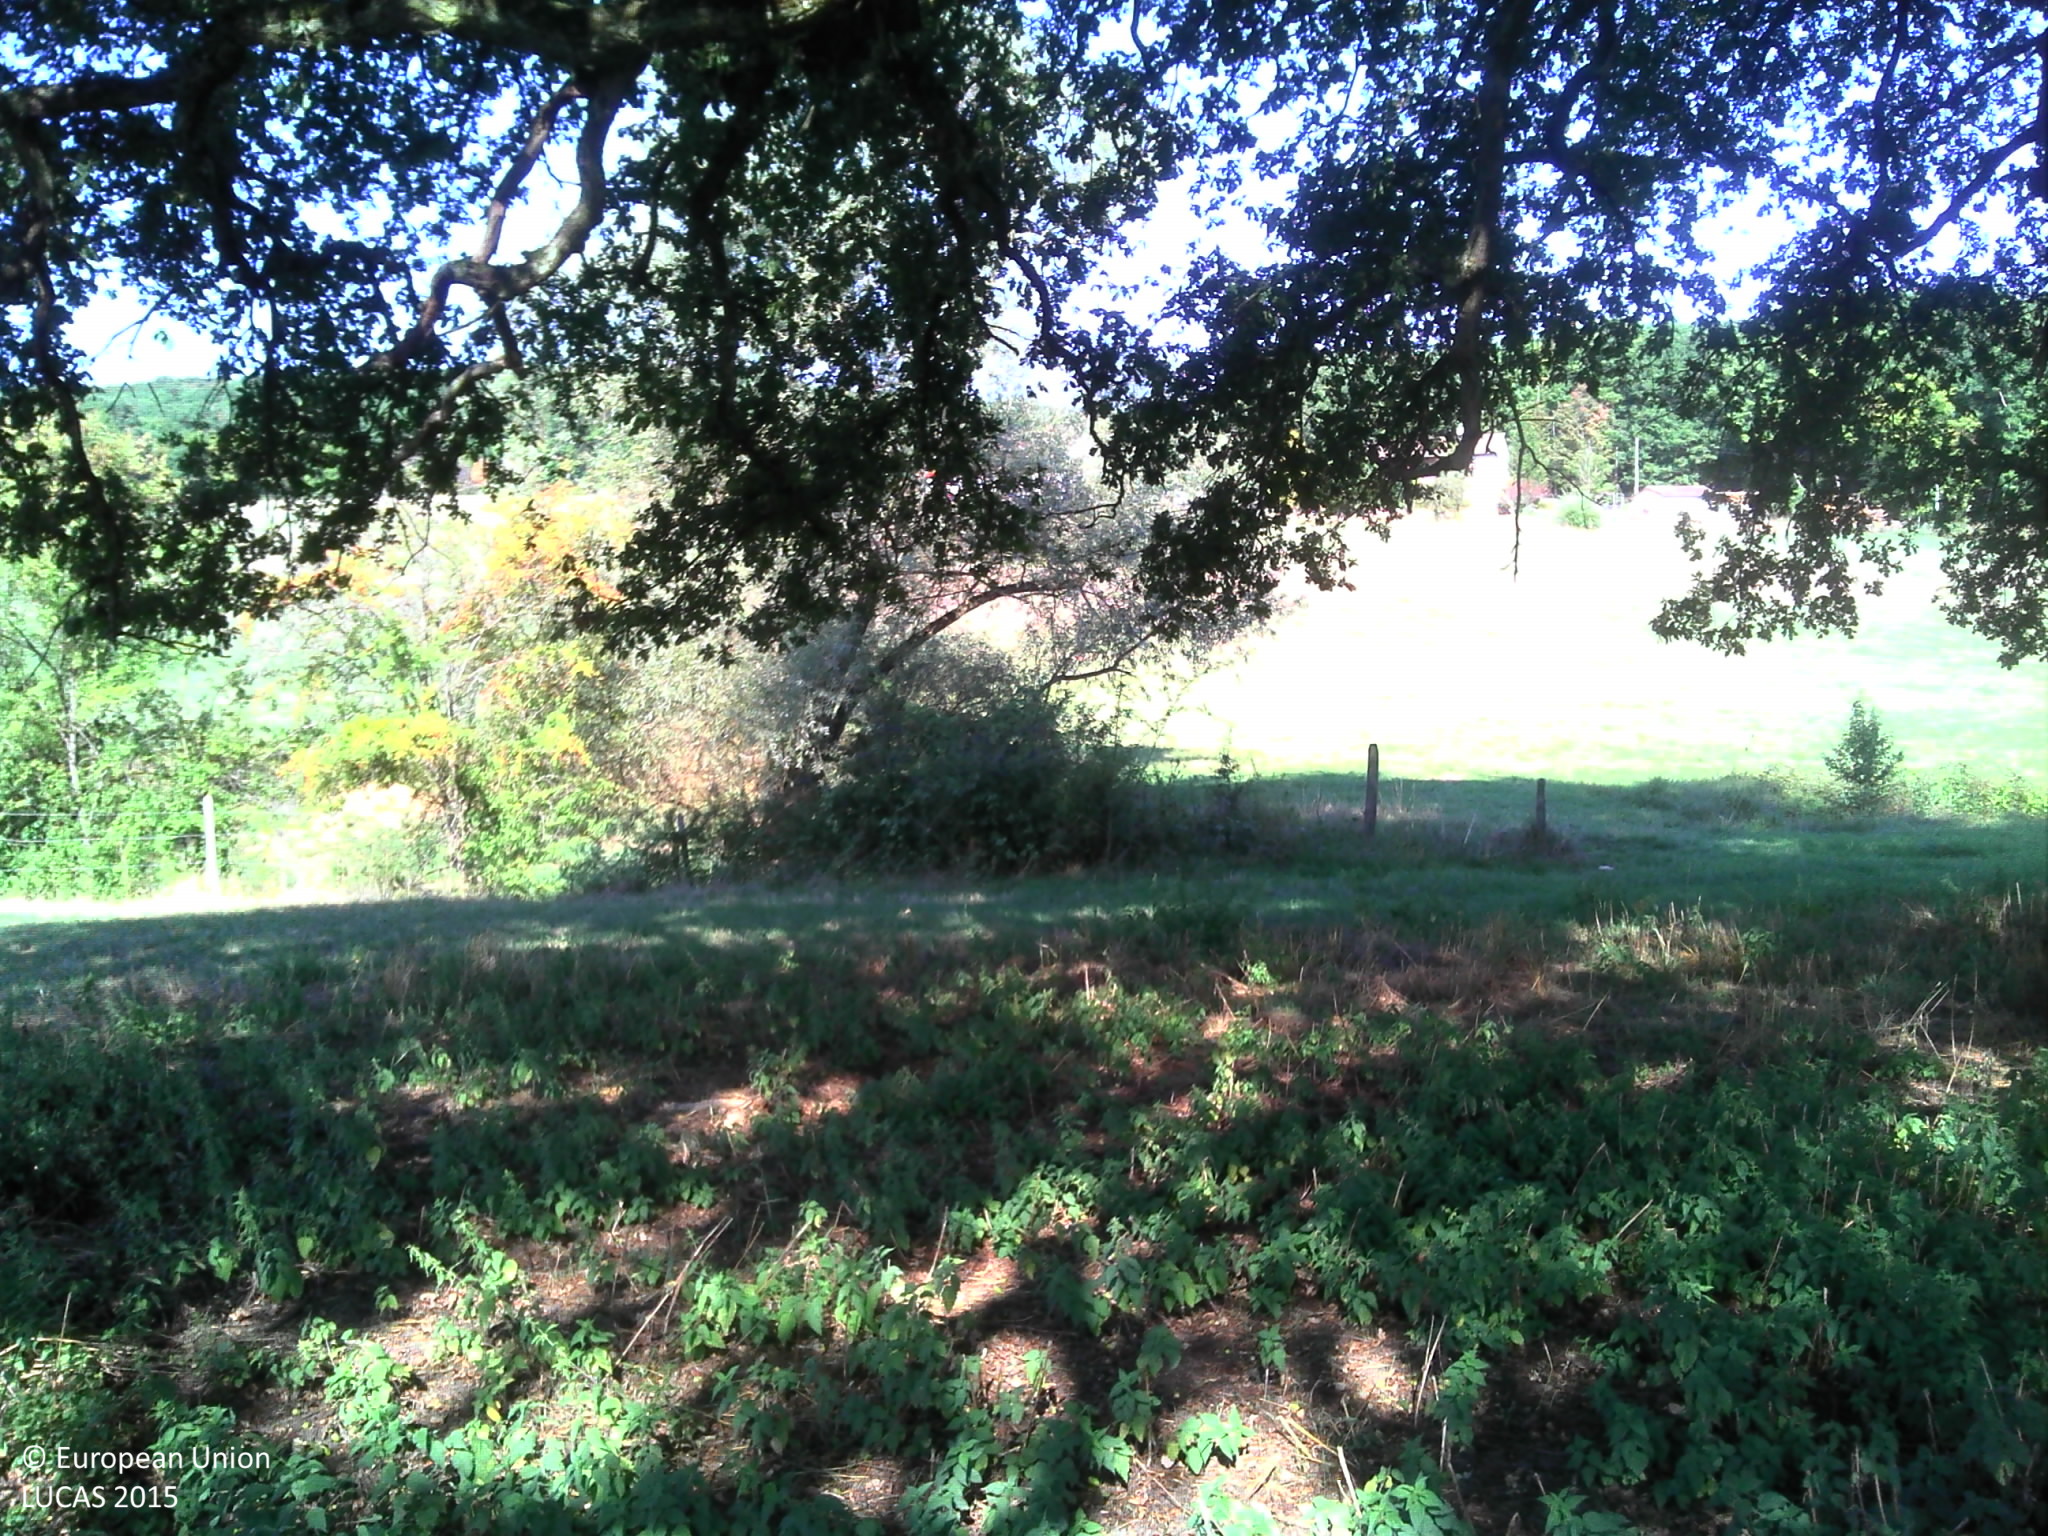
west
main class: Grassland
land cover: Grassland with sparse tree/shrub cover
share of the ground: > 75 %
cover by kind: herbaceous plants 95 %, broadleaved forest trees 5 %
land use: Agriculture (excluding fallow land and kitchen gardens)
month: August
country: FR
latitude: 46.3686
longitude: 4.7895
